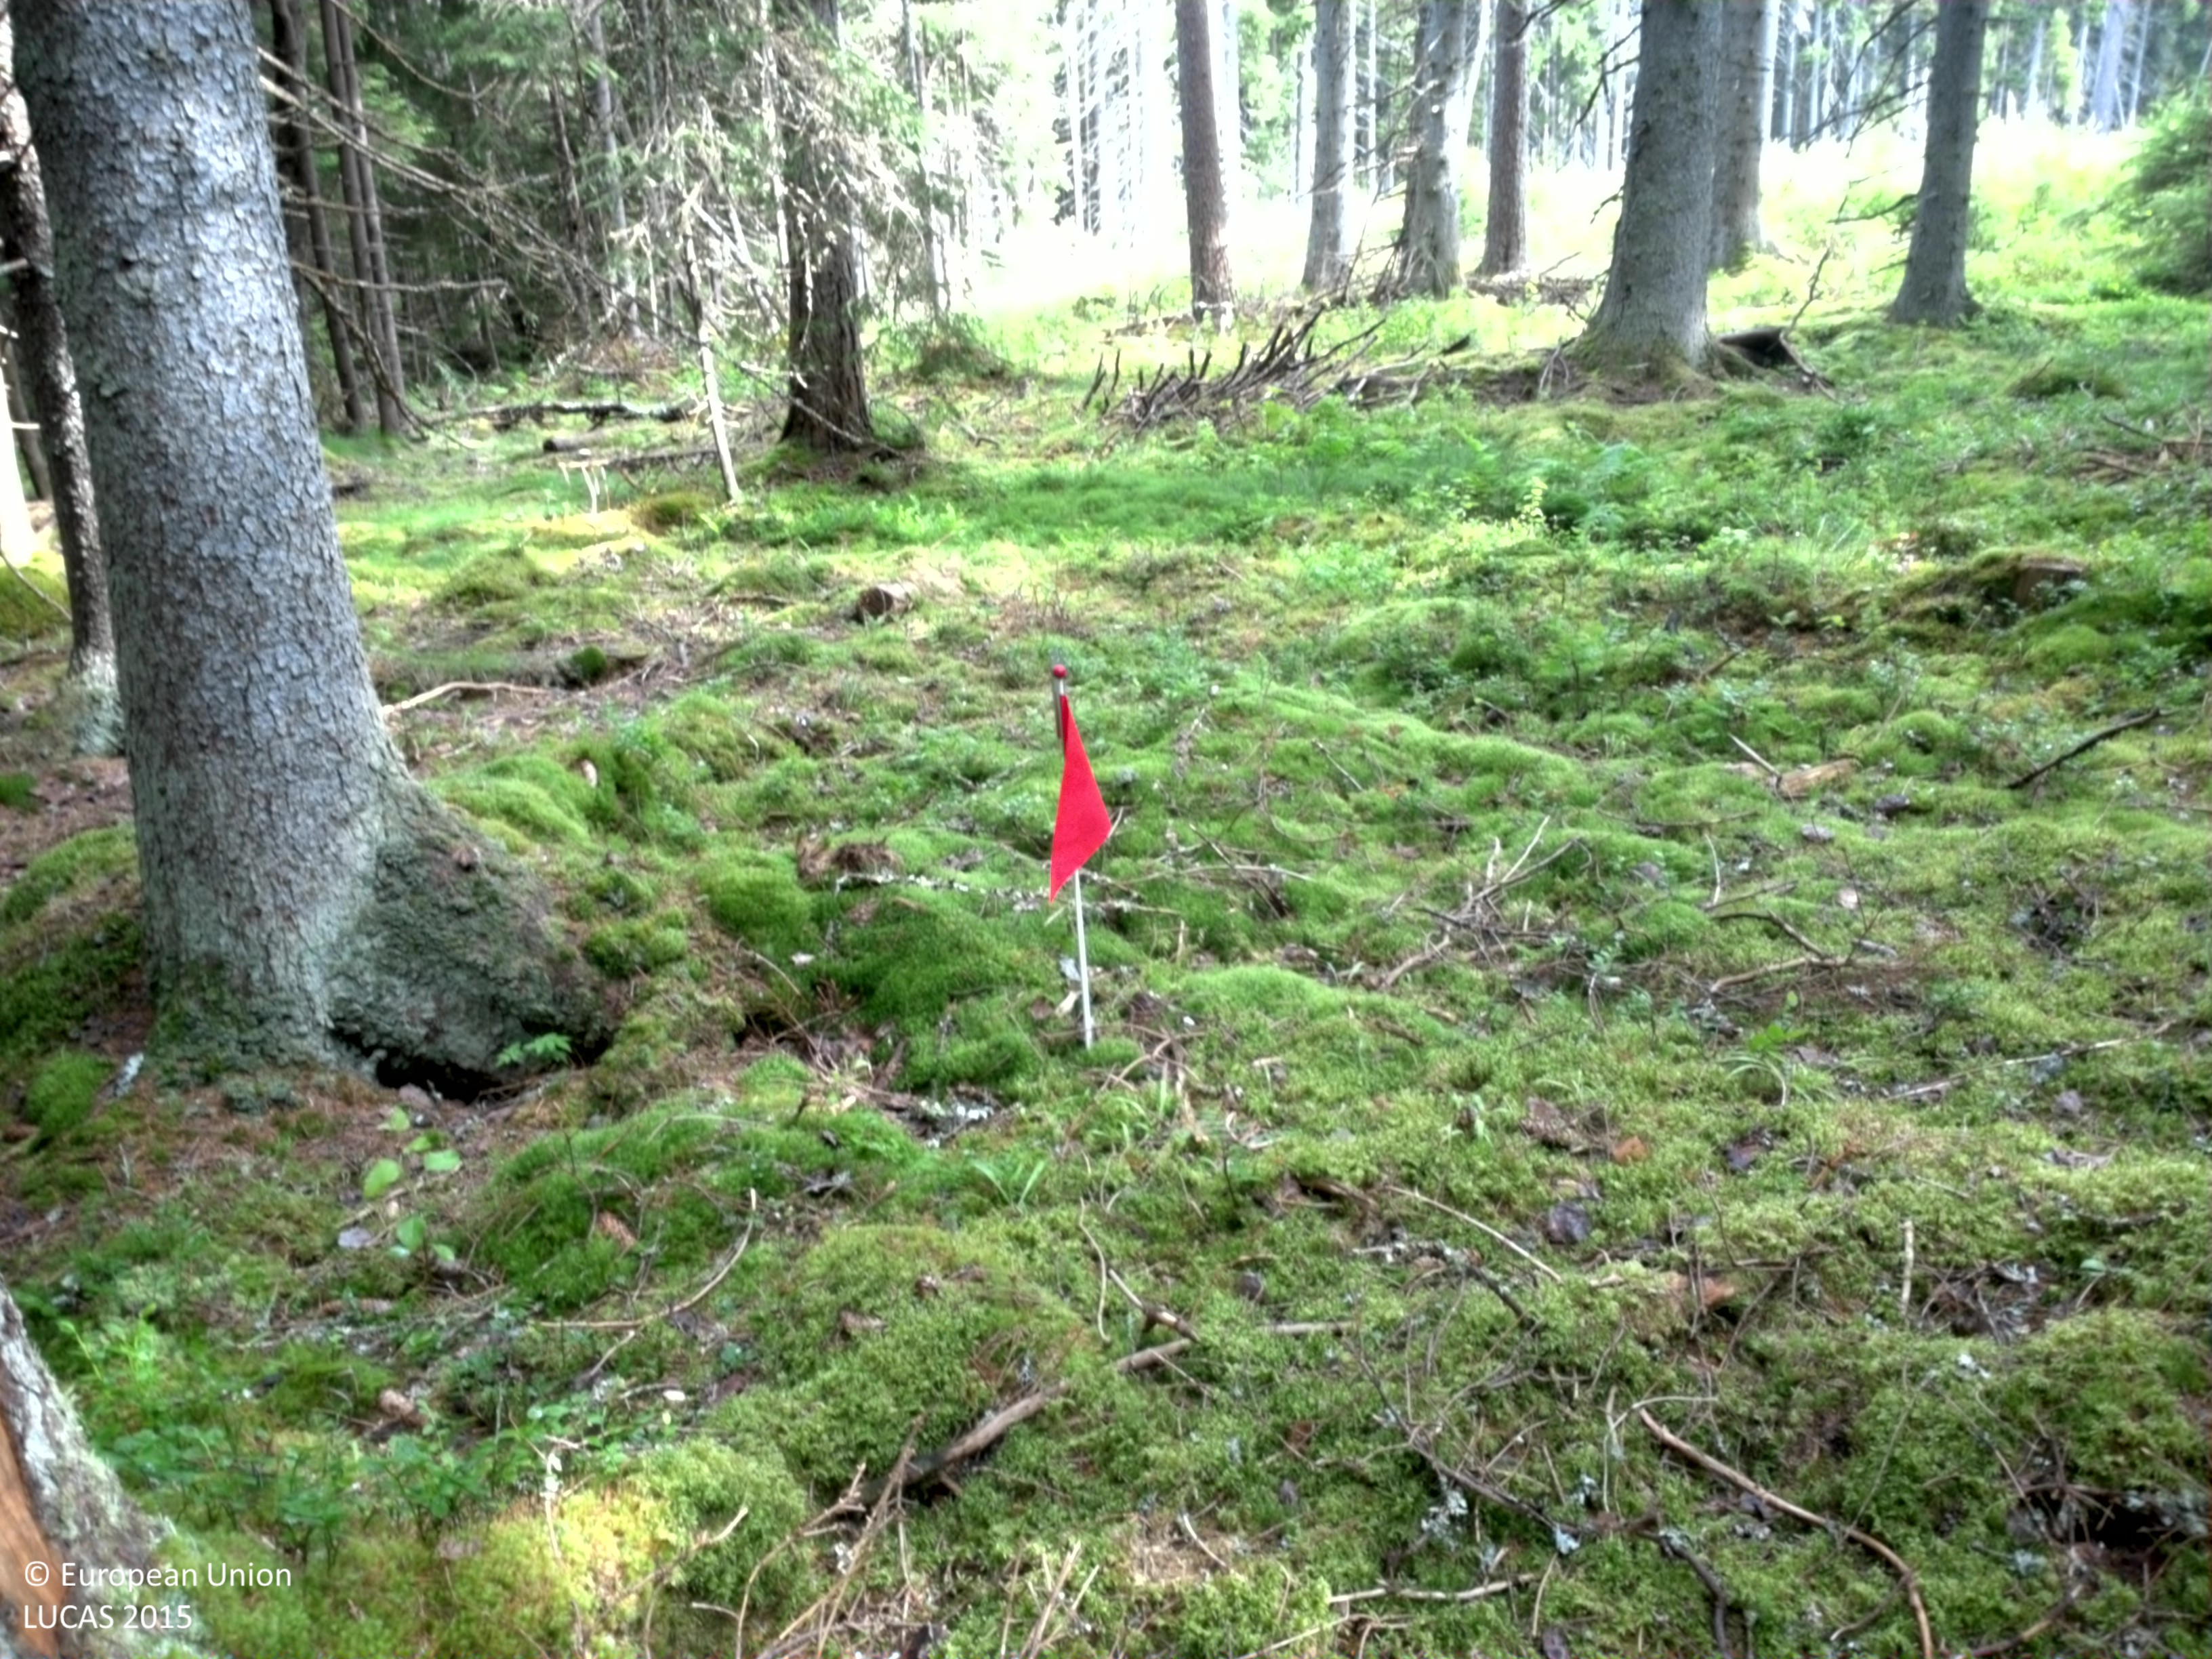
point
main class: Woodland
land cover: Spruce dominated coniferous woodland
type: boreal forest
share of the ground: 50 - 75 %
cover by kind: coniferous forest trees 70 %, lichens and mosses 30 %
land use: Forestry
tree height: > 5 m
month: July
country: SE
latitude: 57.6195
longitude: 14.5660
